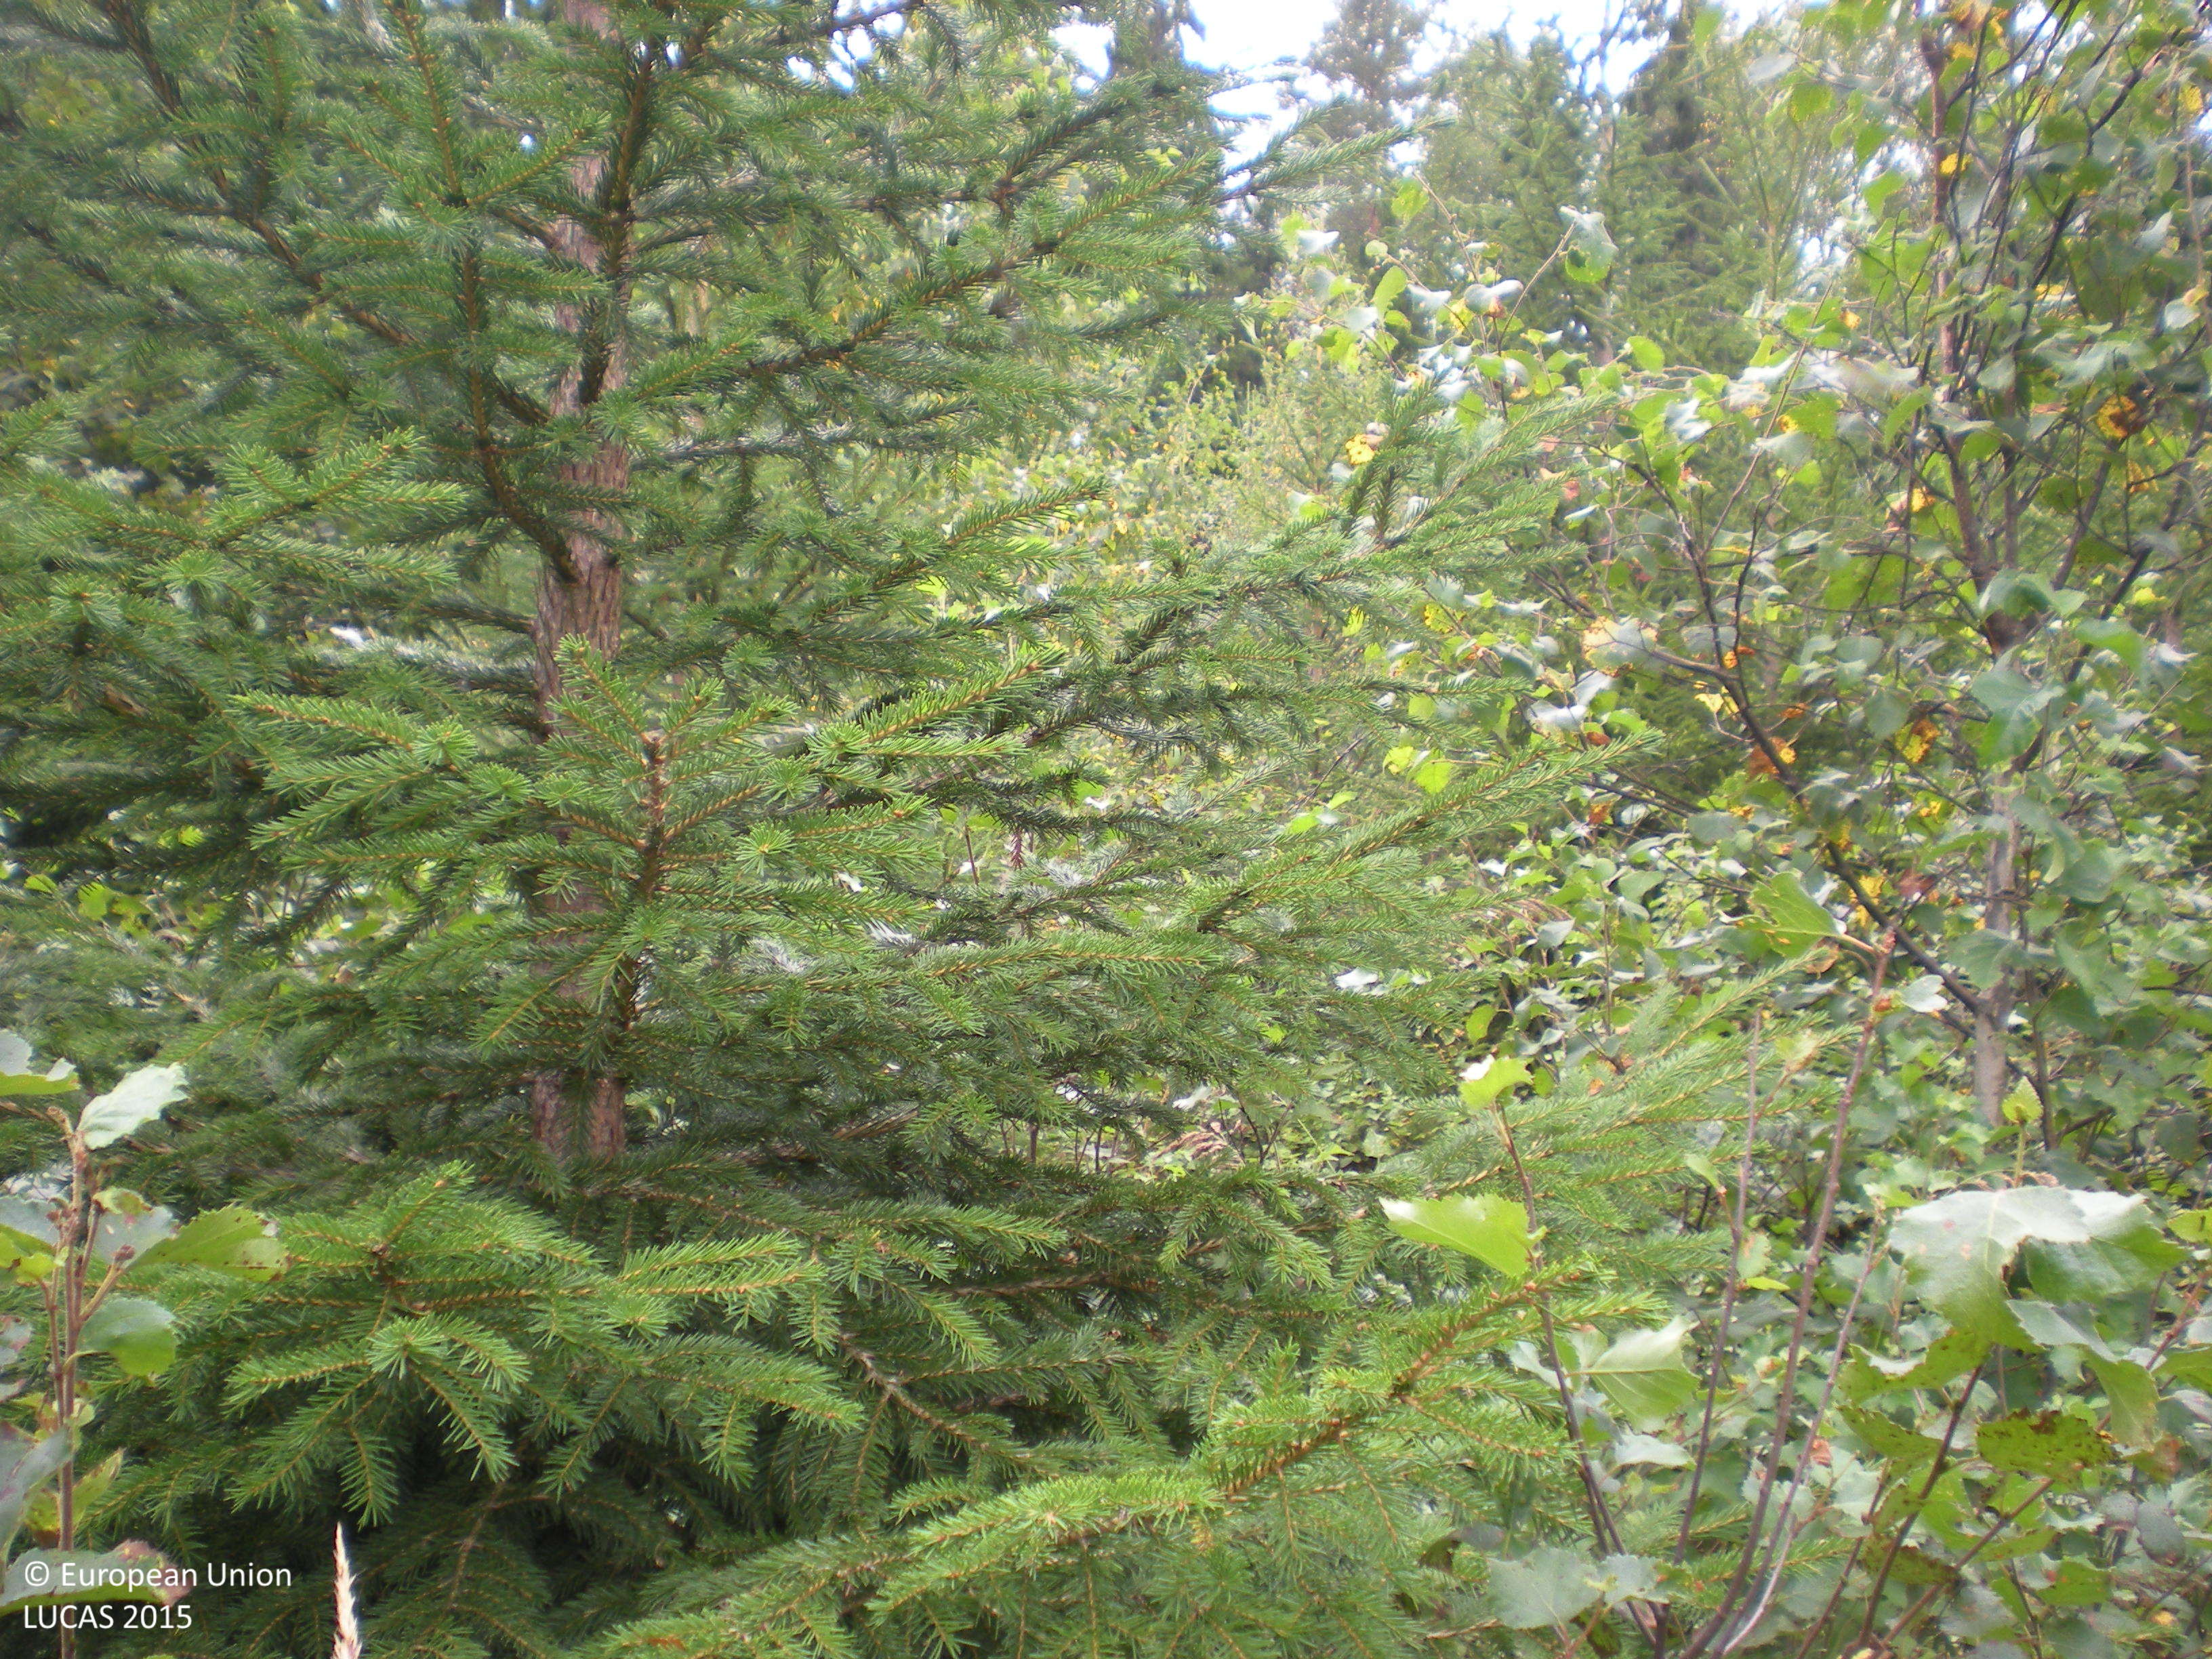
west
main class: Woodland
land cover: Spruce dominated mixed woodland
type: boreal forest
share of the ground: > 75 %
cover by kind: broadleaved forest trees 50 %, coniferous forest trees 40 %, herbaceous plants 10 %
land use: Forestry
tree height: < 5 m
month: August
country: SE
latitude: 60.5095
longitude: 17.0737
